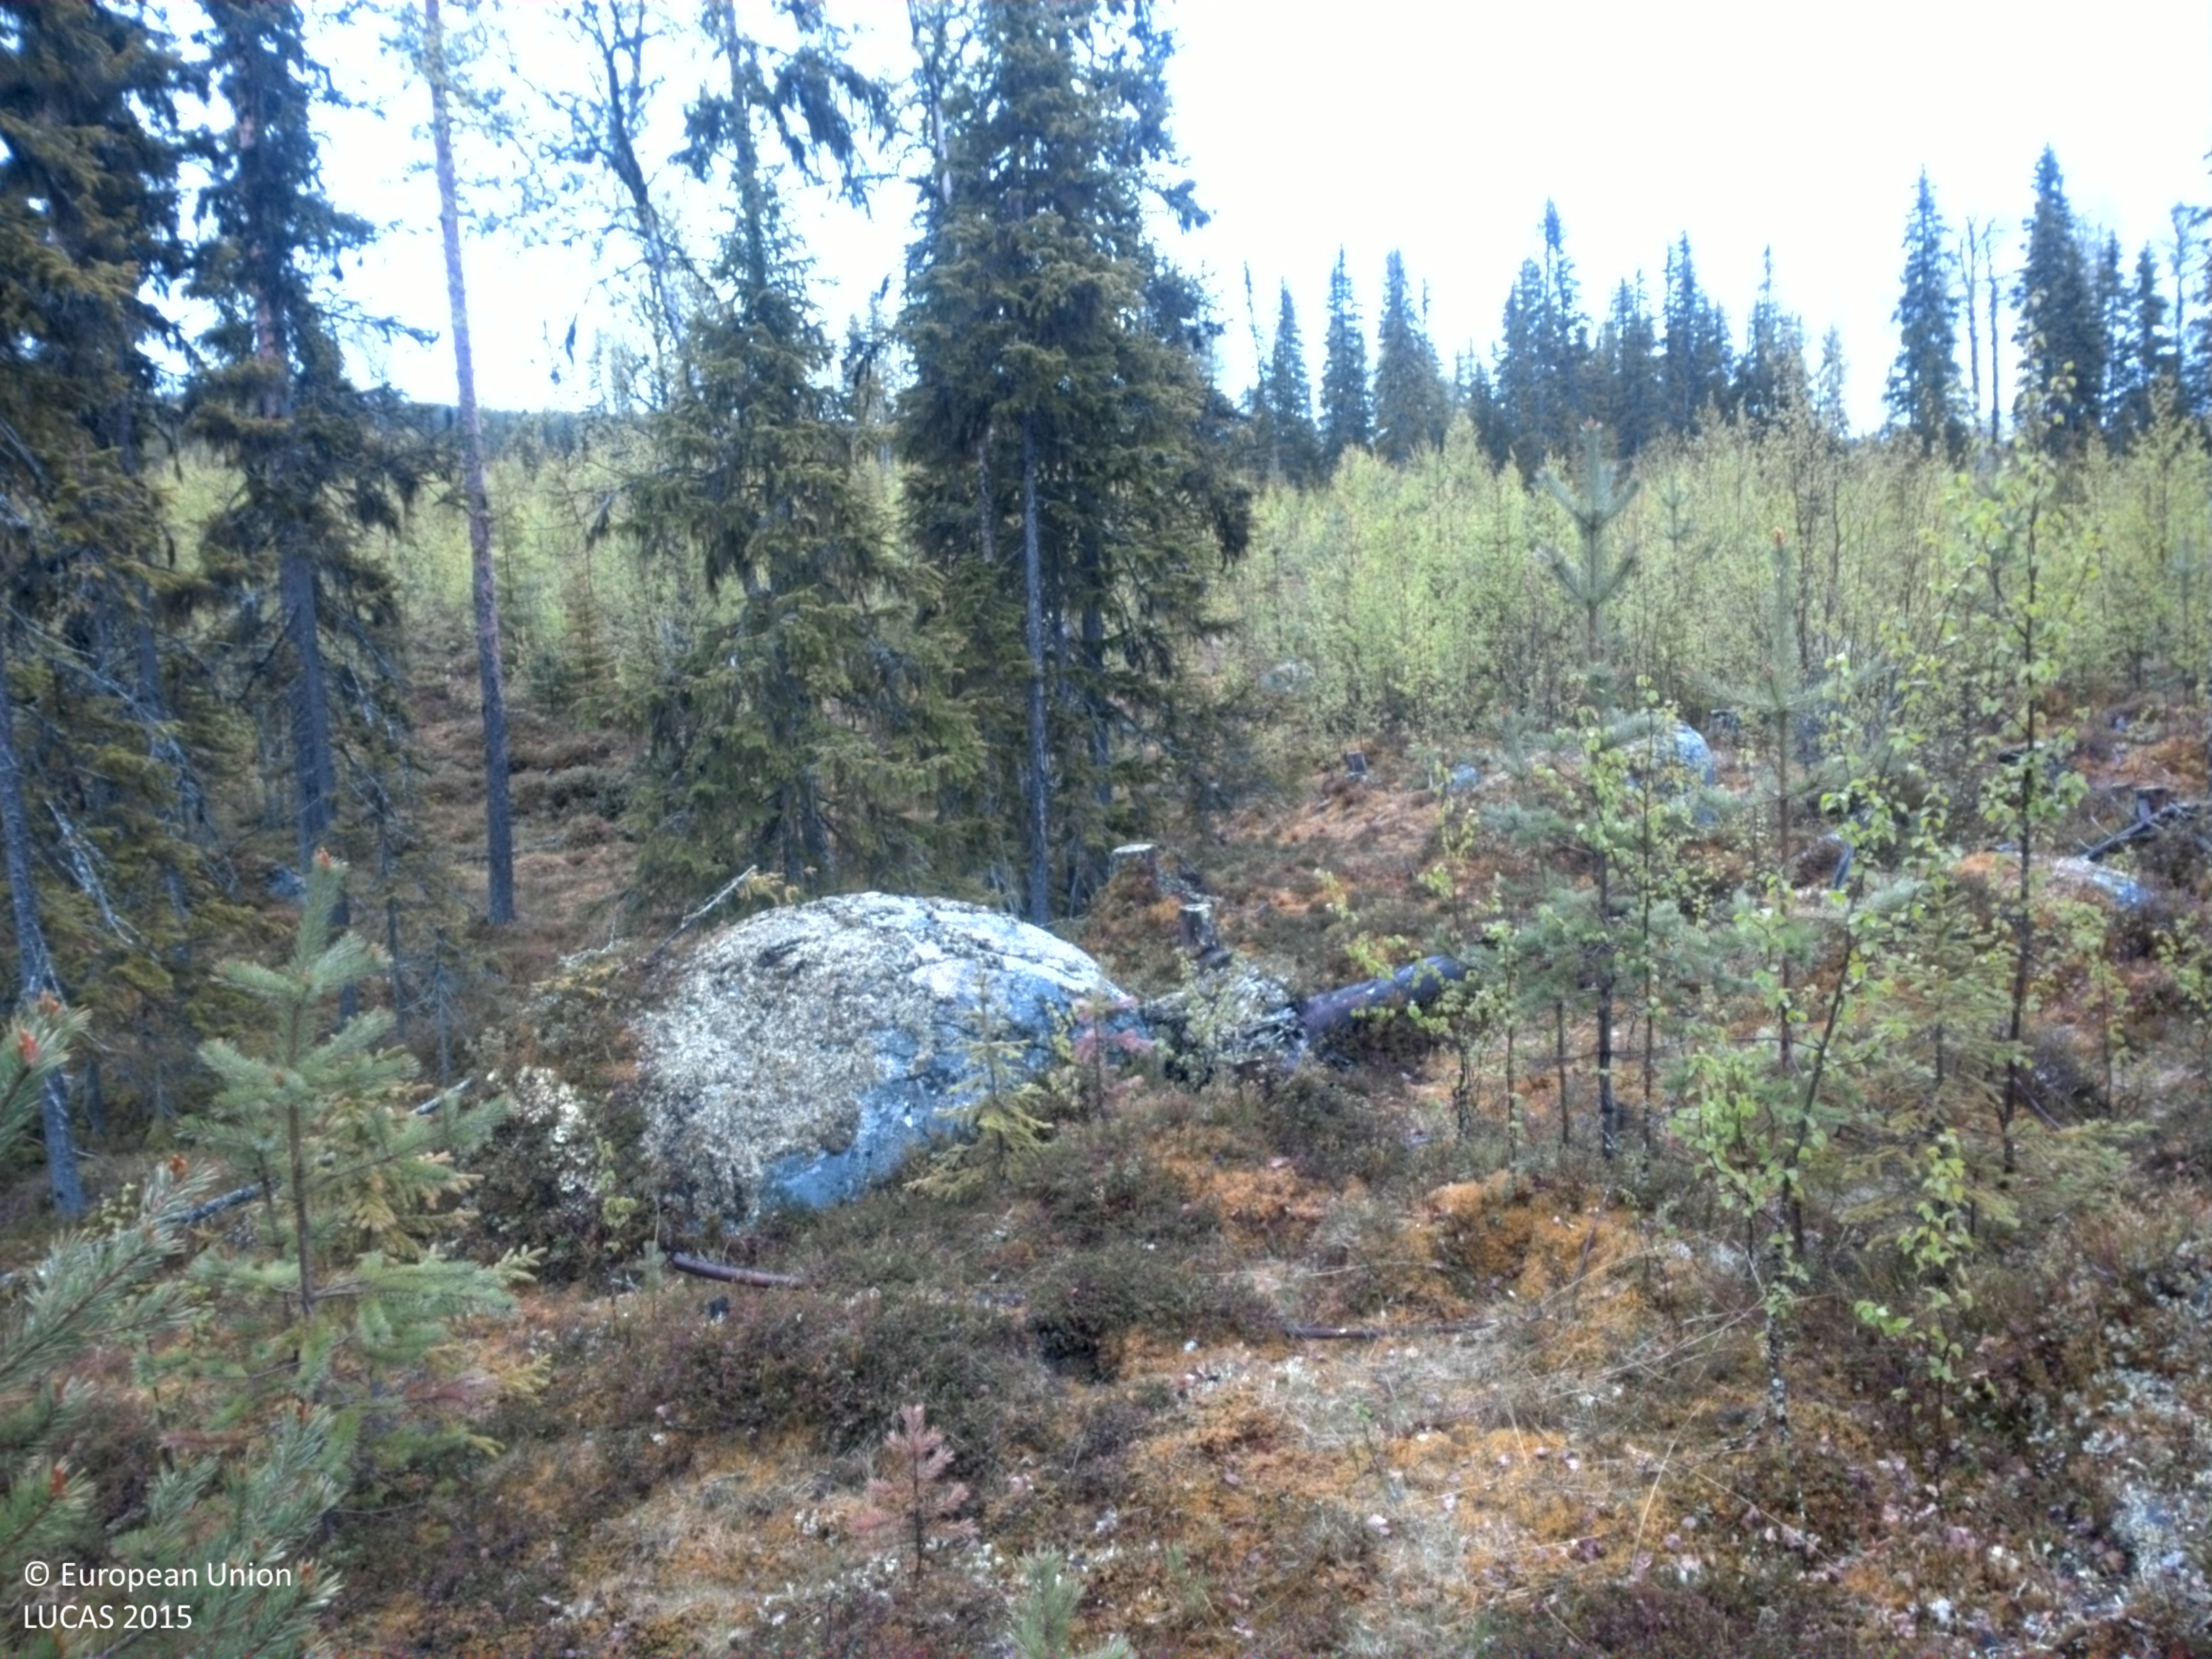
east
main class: Woodland
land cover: Pine dominated mixed woodland
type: boreal forest
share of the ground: 25 - 50 %
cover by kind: coniferous forest trees 30 %, herbaceous plants 25 %, broadleaved forest trees 15 %, lichens and mosses 15 %, unconsolidated bare surface 10 %, shrubs 5 %
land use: Forestry
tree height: < 5 m
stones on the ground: 25 - 50 %
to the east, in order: Pine dominated mixed woodland; Spruce dominated coniferous woodland; Pine dominated mixed woodland; Rocks and stones; Spruce dominated mixed woodland; Rocks and stones; Broadleaved woodland; Rocks and stones; Broadleaved woodland; Spruce dominated coniferous woodland; Spruce dominated mixed woodland; Shrubland without tree cover; Paved roads, cycling and walking lanes; Shrubland without tree cover; Ditches and canals; Spruce dominated mixed woodland
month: June
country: SE
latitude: 64.4420
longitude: 17.4256
